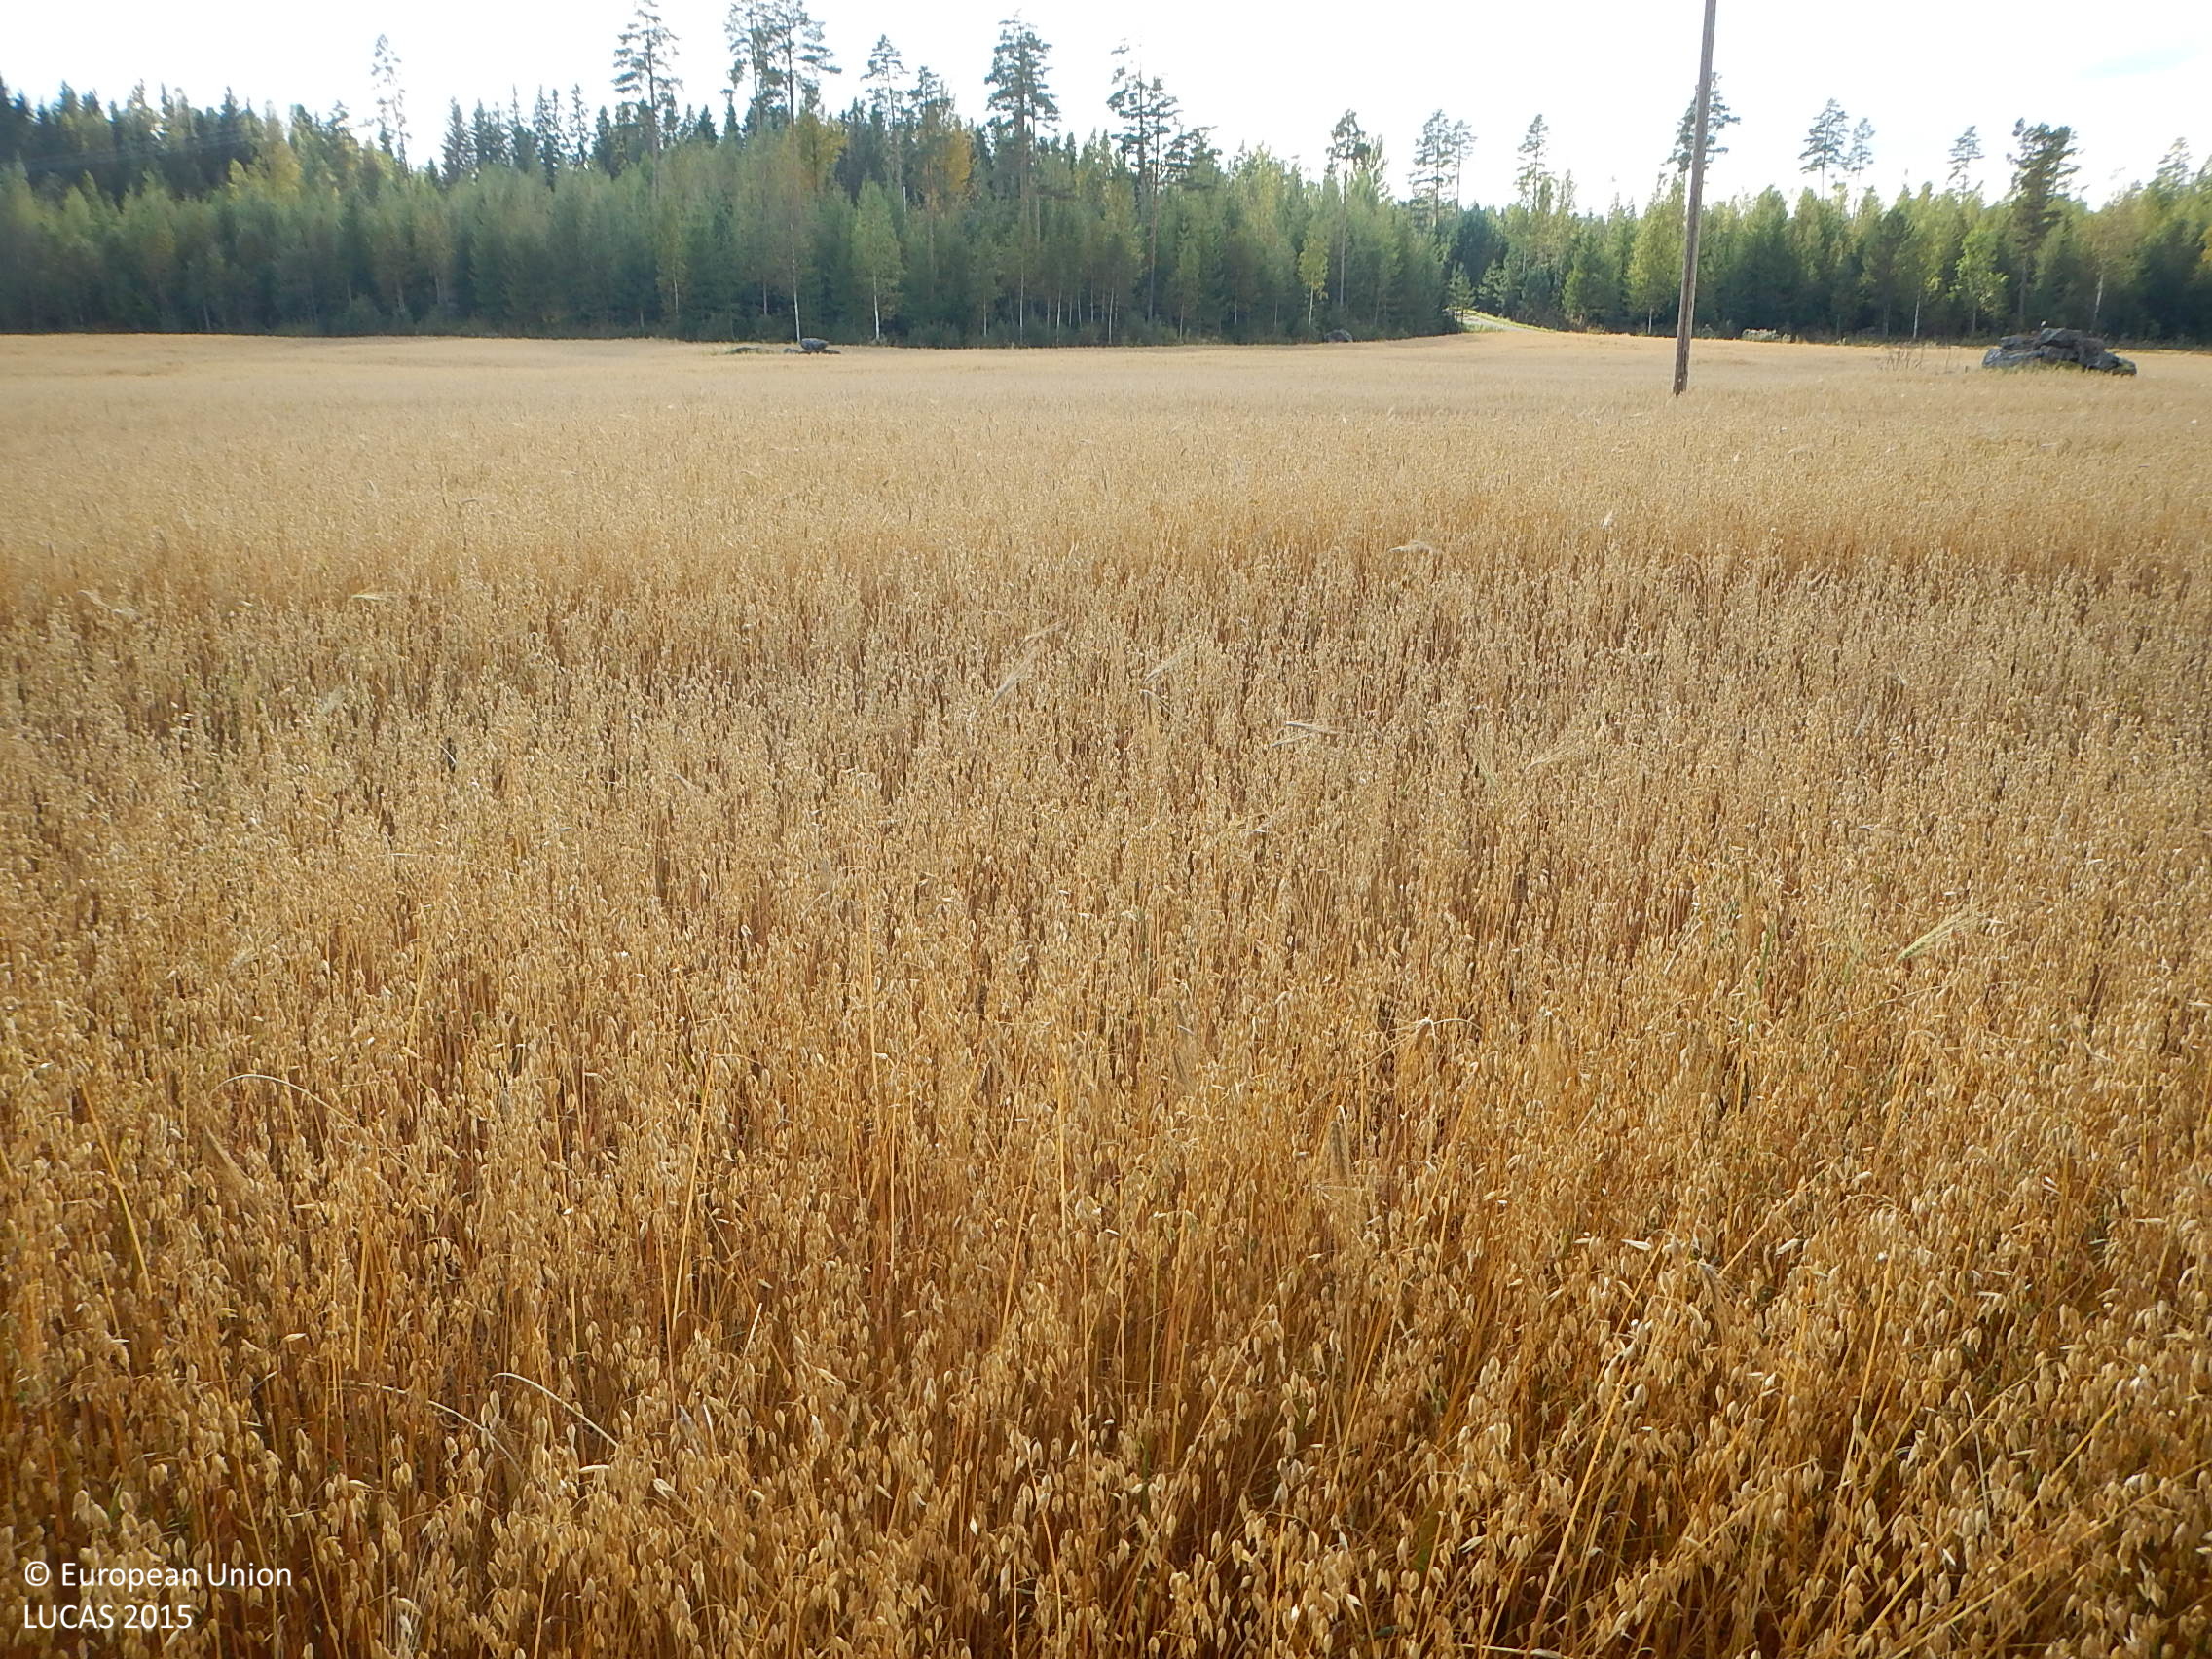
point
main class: Cropland
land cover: Oats
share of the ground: > 75 %
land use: Agriculture (excluding fallow land and kitchen gardens)
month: September
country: FI
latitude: 61.5387
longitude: 22.3058
